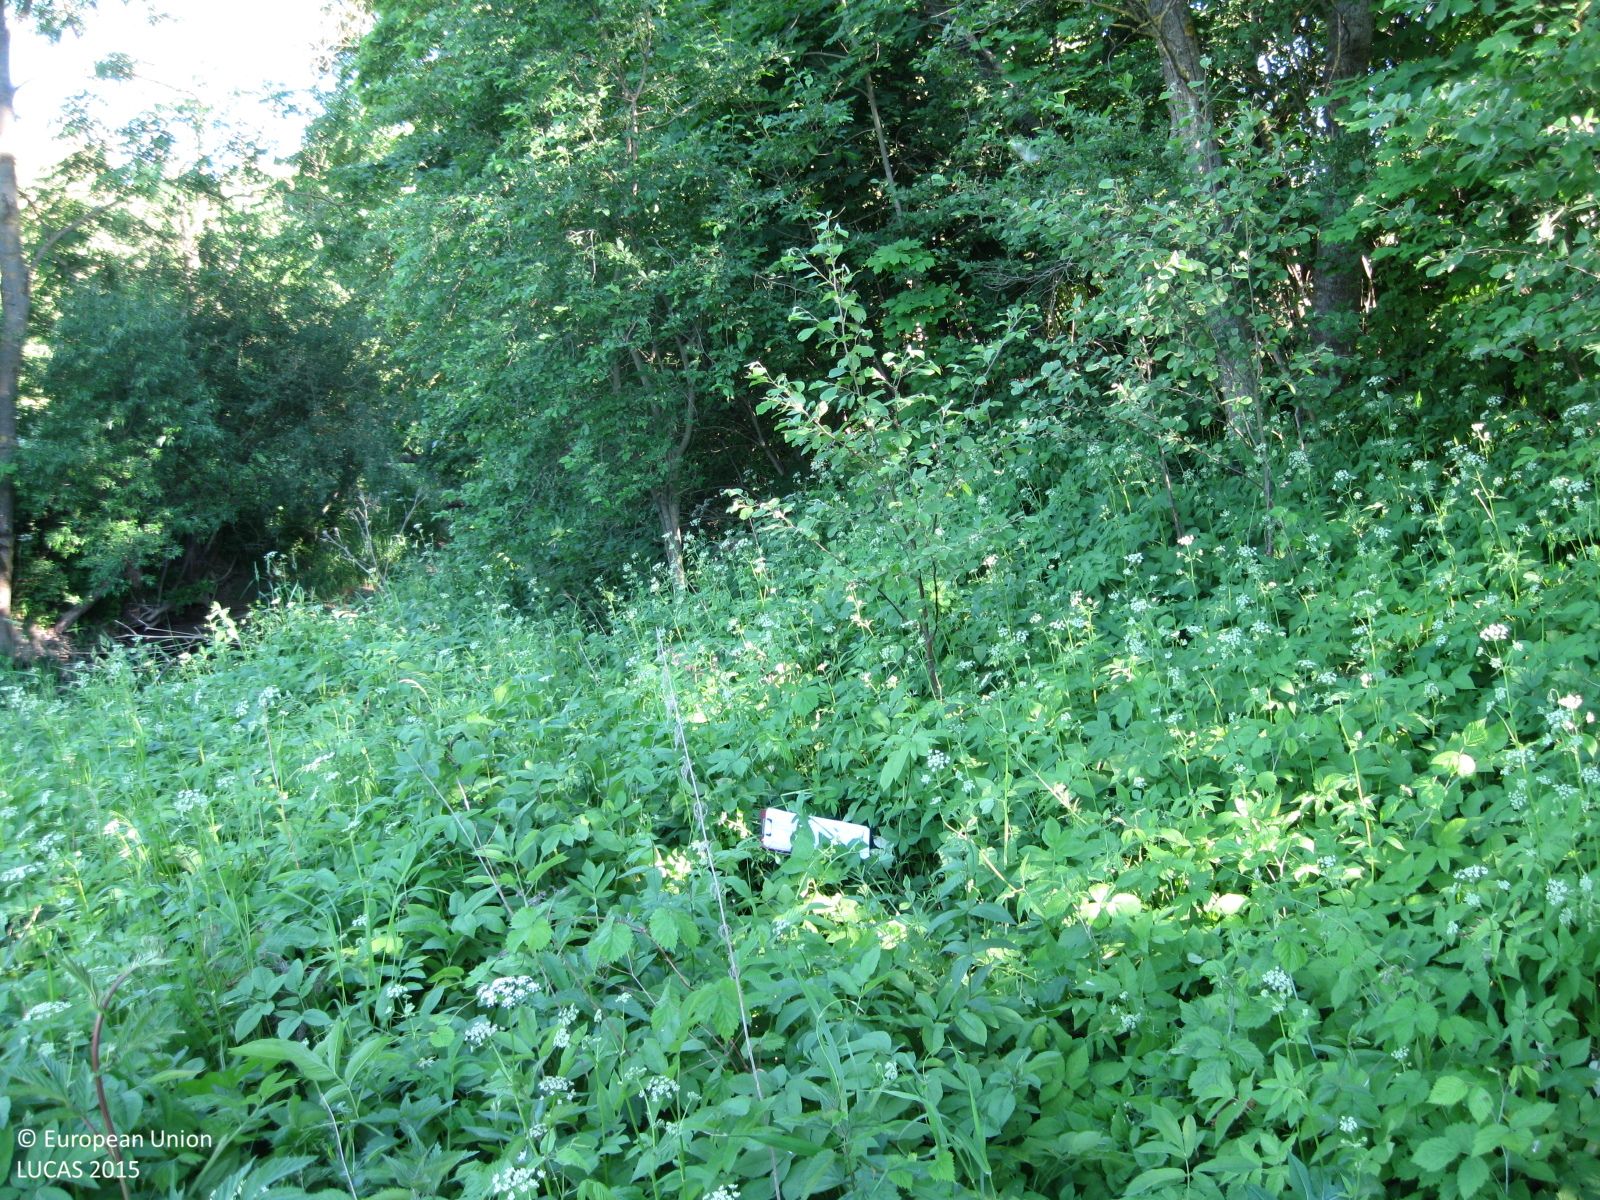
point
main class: Grassland
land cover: Spontaneously vegetated surfaces
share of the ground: > 75 %
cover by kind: herbaceous plants 100 %
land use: Semi-natural and natural areas not in use
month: June
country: LT
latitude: 55.6884
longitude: 24.0071
